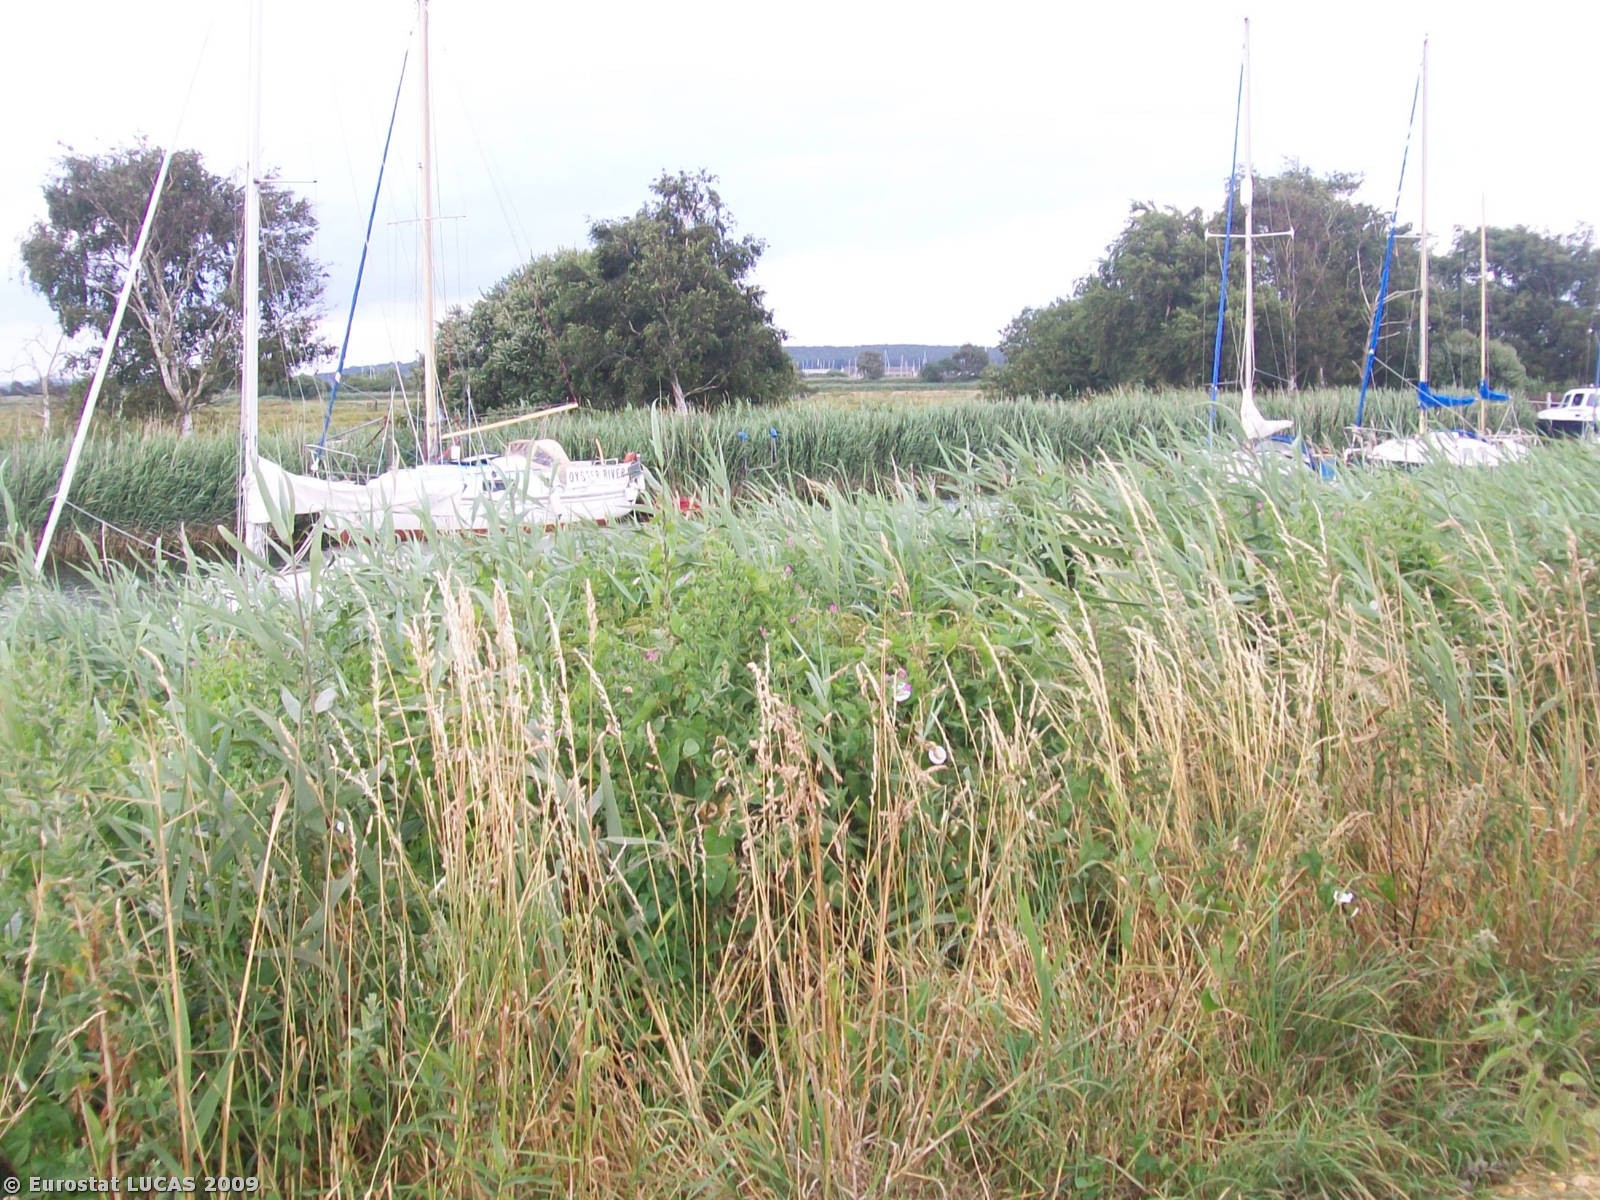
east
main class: Grassland
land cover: Grassland without tree/shrub cover
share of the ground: > 75 %
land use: Agriculture (excluding fallow land and kitchen gardens)
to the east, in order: Grassland without tree/shrub cover; Ditches and canals; Inland marshes; Tracks; Inland marshes; Inland running water; Inland marshes; Broadleaved woodland; Grassland without tree/shrub cover
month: July
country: GB
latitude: 50.6823
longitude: -2.1039
